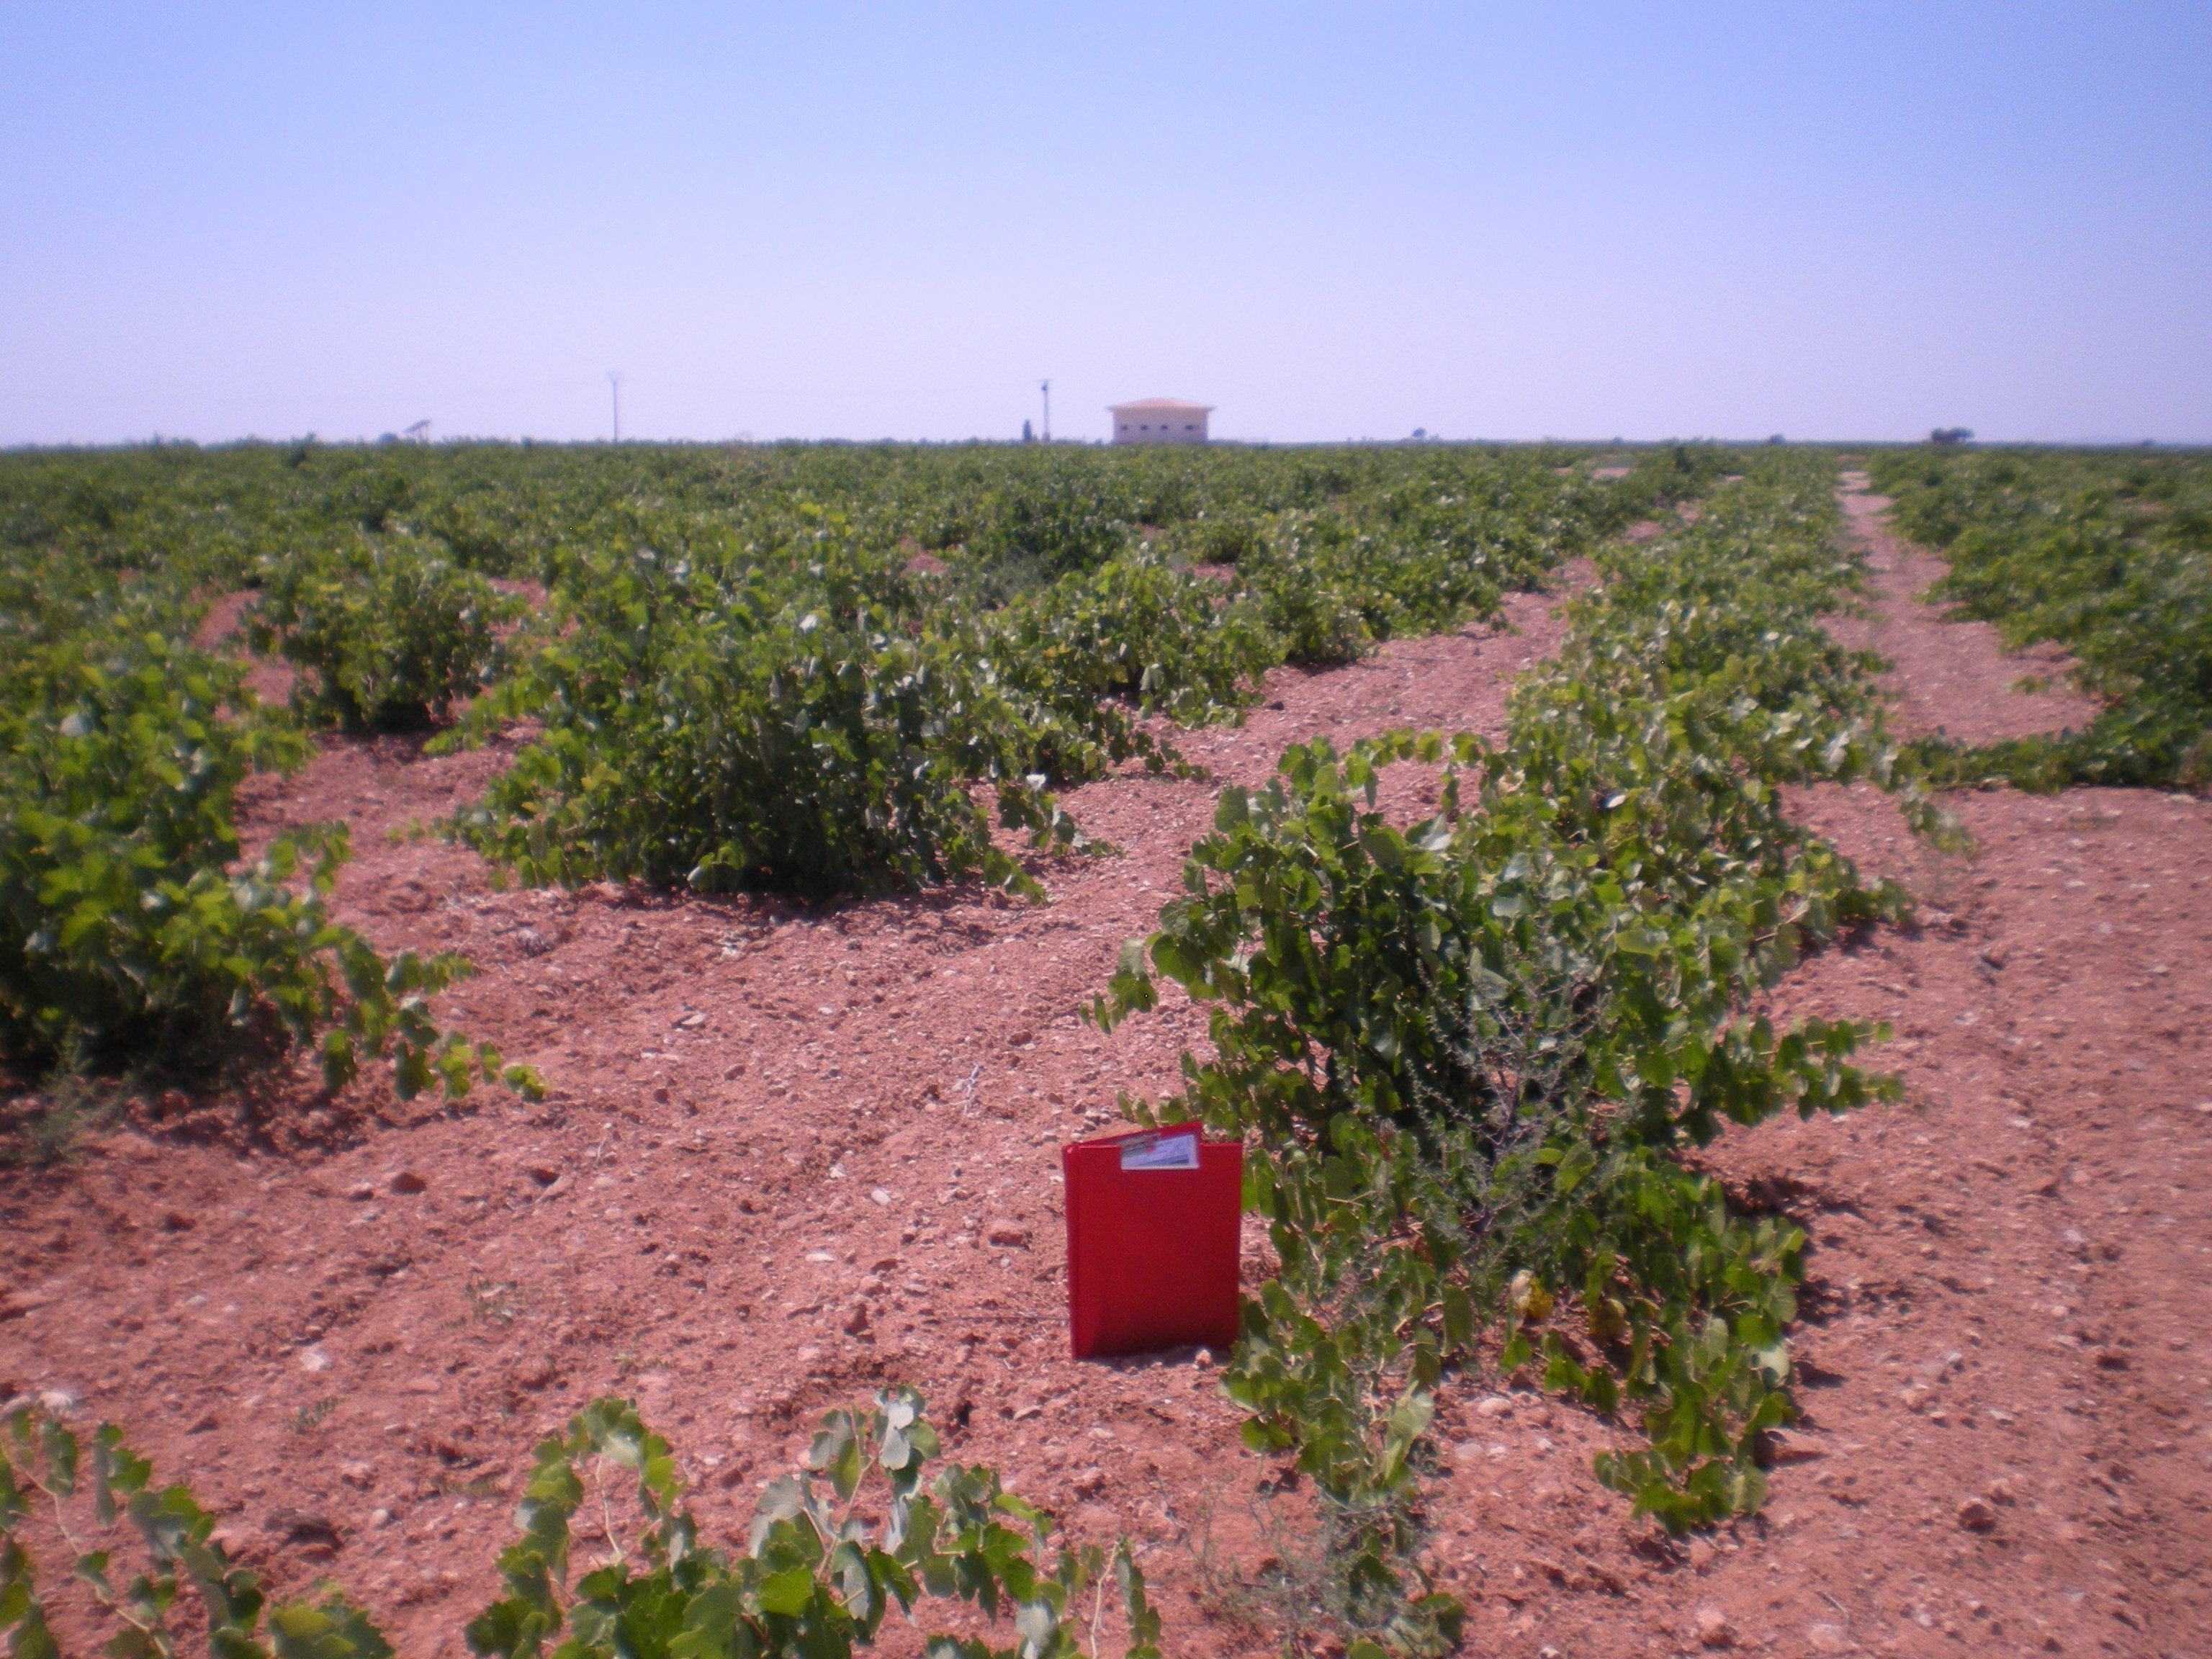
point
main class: Cropland
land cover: Vineyards
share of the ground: 10 - 25 %
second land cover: Other bare soil
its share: > 75 %
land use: Agriculture (excluding fallow land and kitchen gardens)
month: July
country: ES
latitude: 39.5544
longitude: -3.0647
